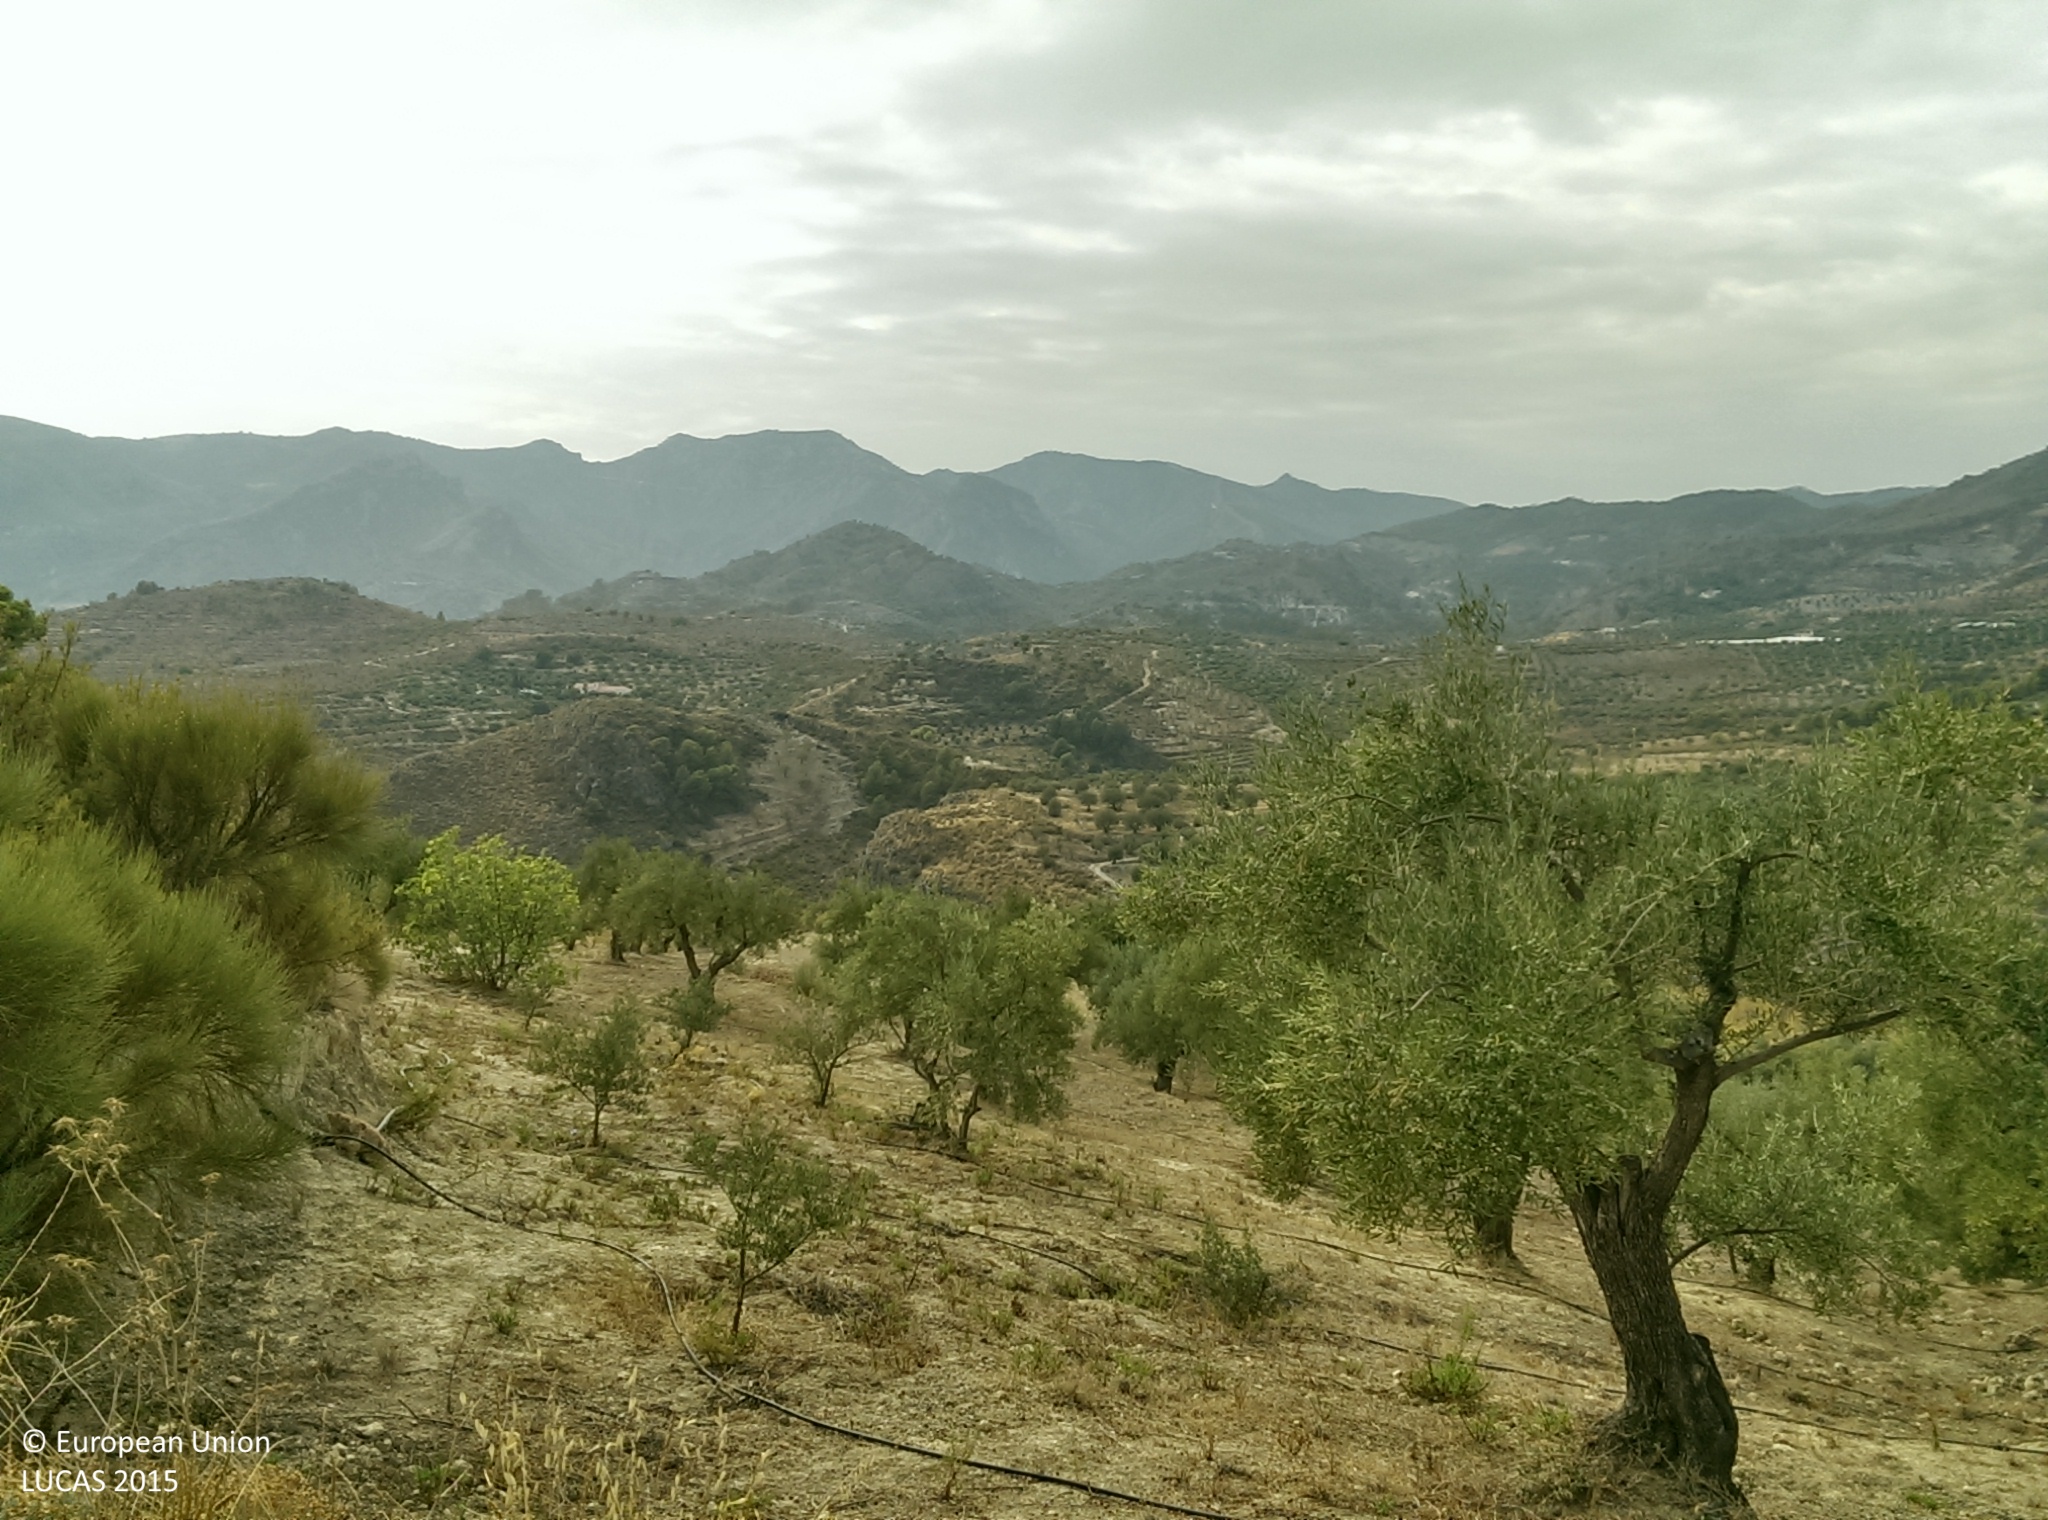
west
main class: Cropland
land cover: Olive groves
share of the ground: 50 - 75 %
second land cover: Spontaneously vegetated surfaces
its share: 50 - 75 %
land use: Agriculture (excluding fallow land and kitchen gardens)
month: August
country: ES
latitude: 36.8589
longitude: -3.5893
